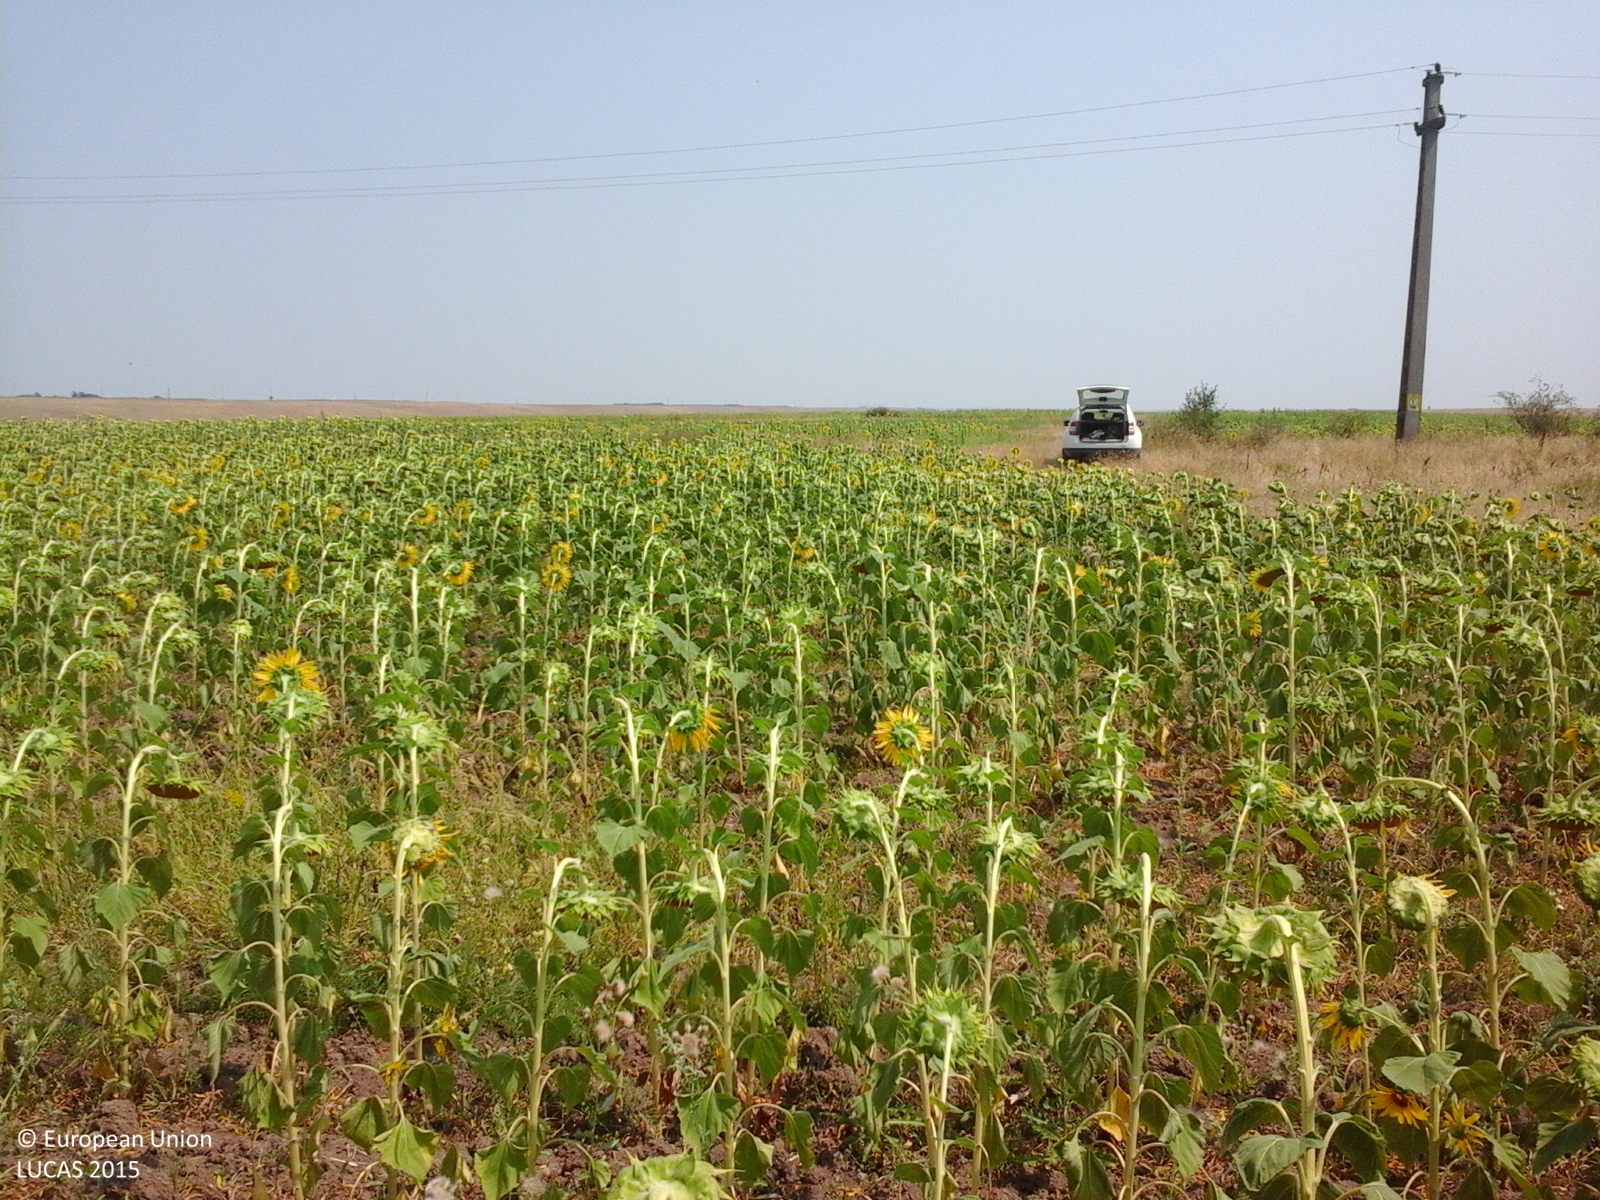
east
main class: Cropland
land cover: Sunflower
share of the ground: 50 - 75 %
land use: Agriculture (excluding fallow land and kitchen gardens)
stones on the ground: < 10 %
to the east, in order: Sunflower; Tracks; Grassland without tree/shrub cover; Tracks; Grass margins; Electric lines; Grass margins; Sunflower; Common wheat; Sunflower; Spontaneously vegetated surfaces; Common wheat; Sunflower
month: August
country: RO
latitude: 44.3326
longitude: 23.5597
